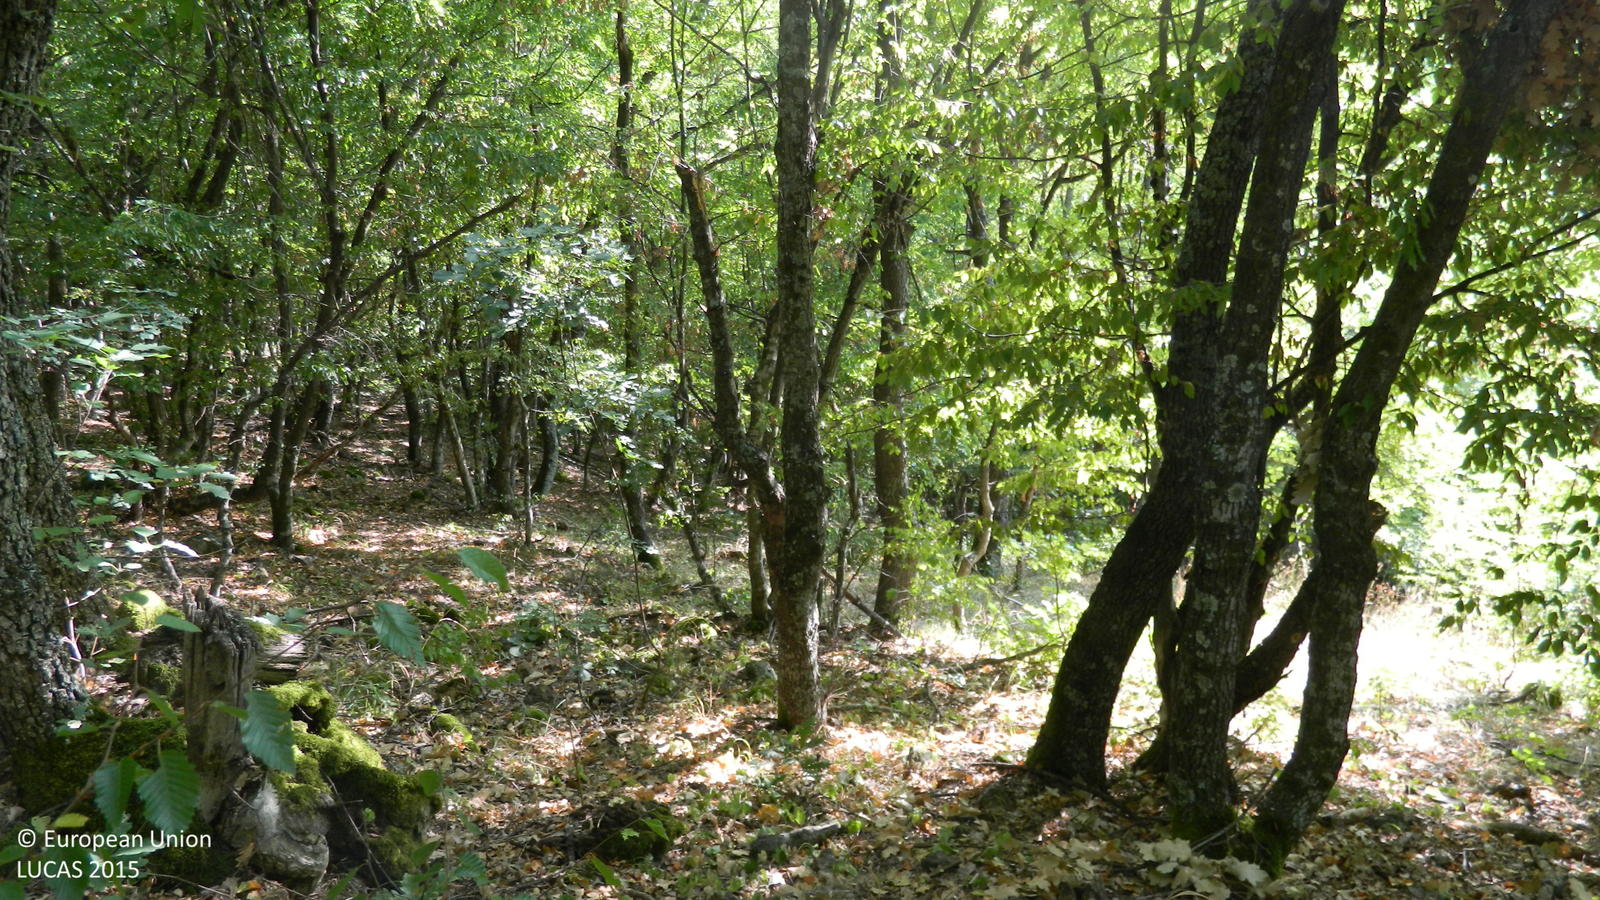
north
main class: Woodland
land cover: Broadleaved woodland
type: mesophytic deciduous forest
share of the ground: > 75 %
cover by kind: broadleaved forest trees 100 %
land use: Forestry
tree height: > 5 m
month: August
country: BG
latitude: 41.6566
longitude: 25.8334
